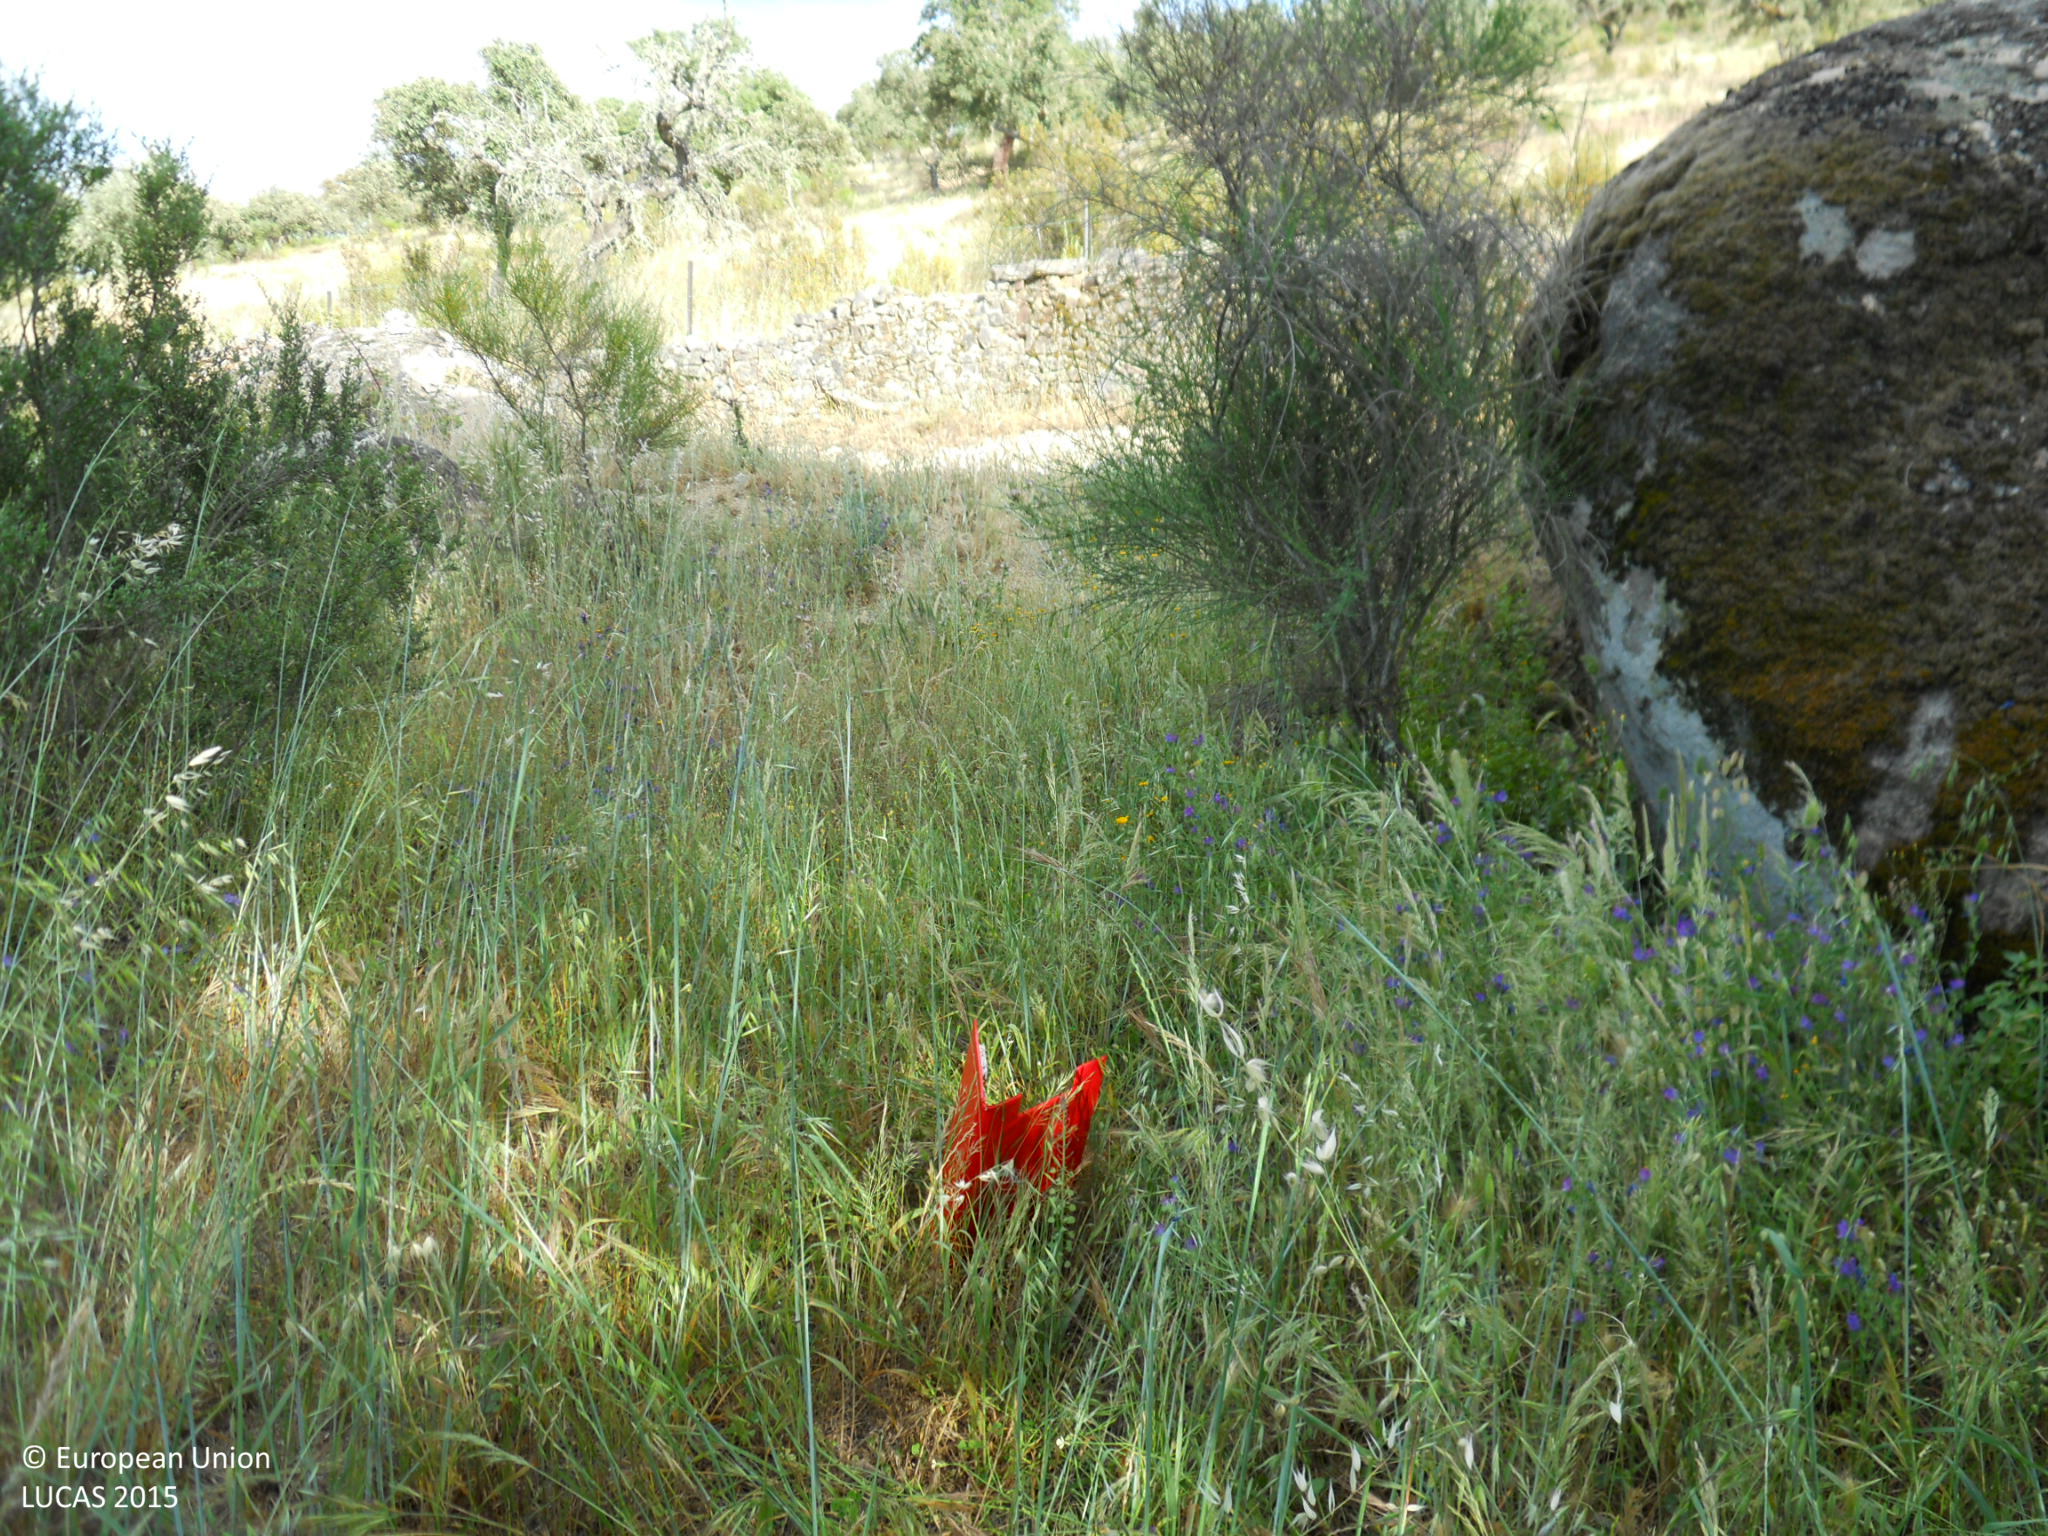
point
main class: Shrubland
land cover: Shrubland with sparse tree cover
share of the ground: > 75 %
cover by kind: shrubs 80 %, herbaceous plants 10 %, broadleaved forest trees 5 %, consolidated bare surface 5 %
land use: Agriculture (excluding fallow land and kitchen gardens)
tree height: > 5 m
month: May
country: ES
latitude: 39.0602
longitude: -6.2962
